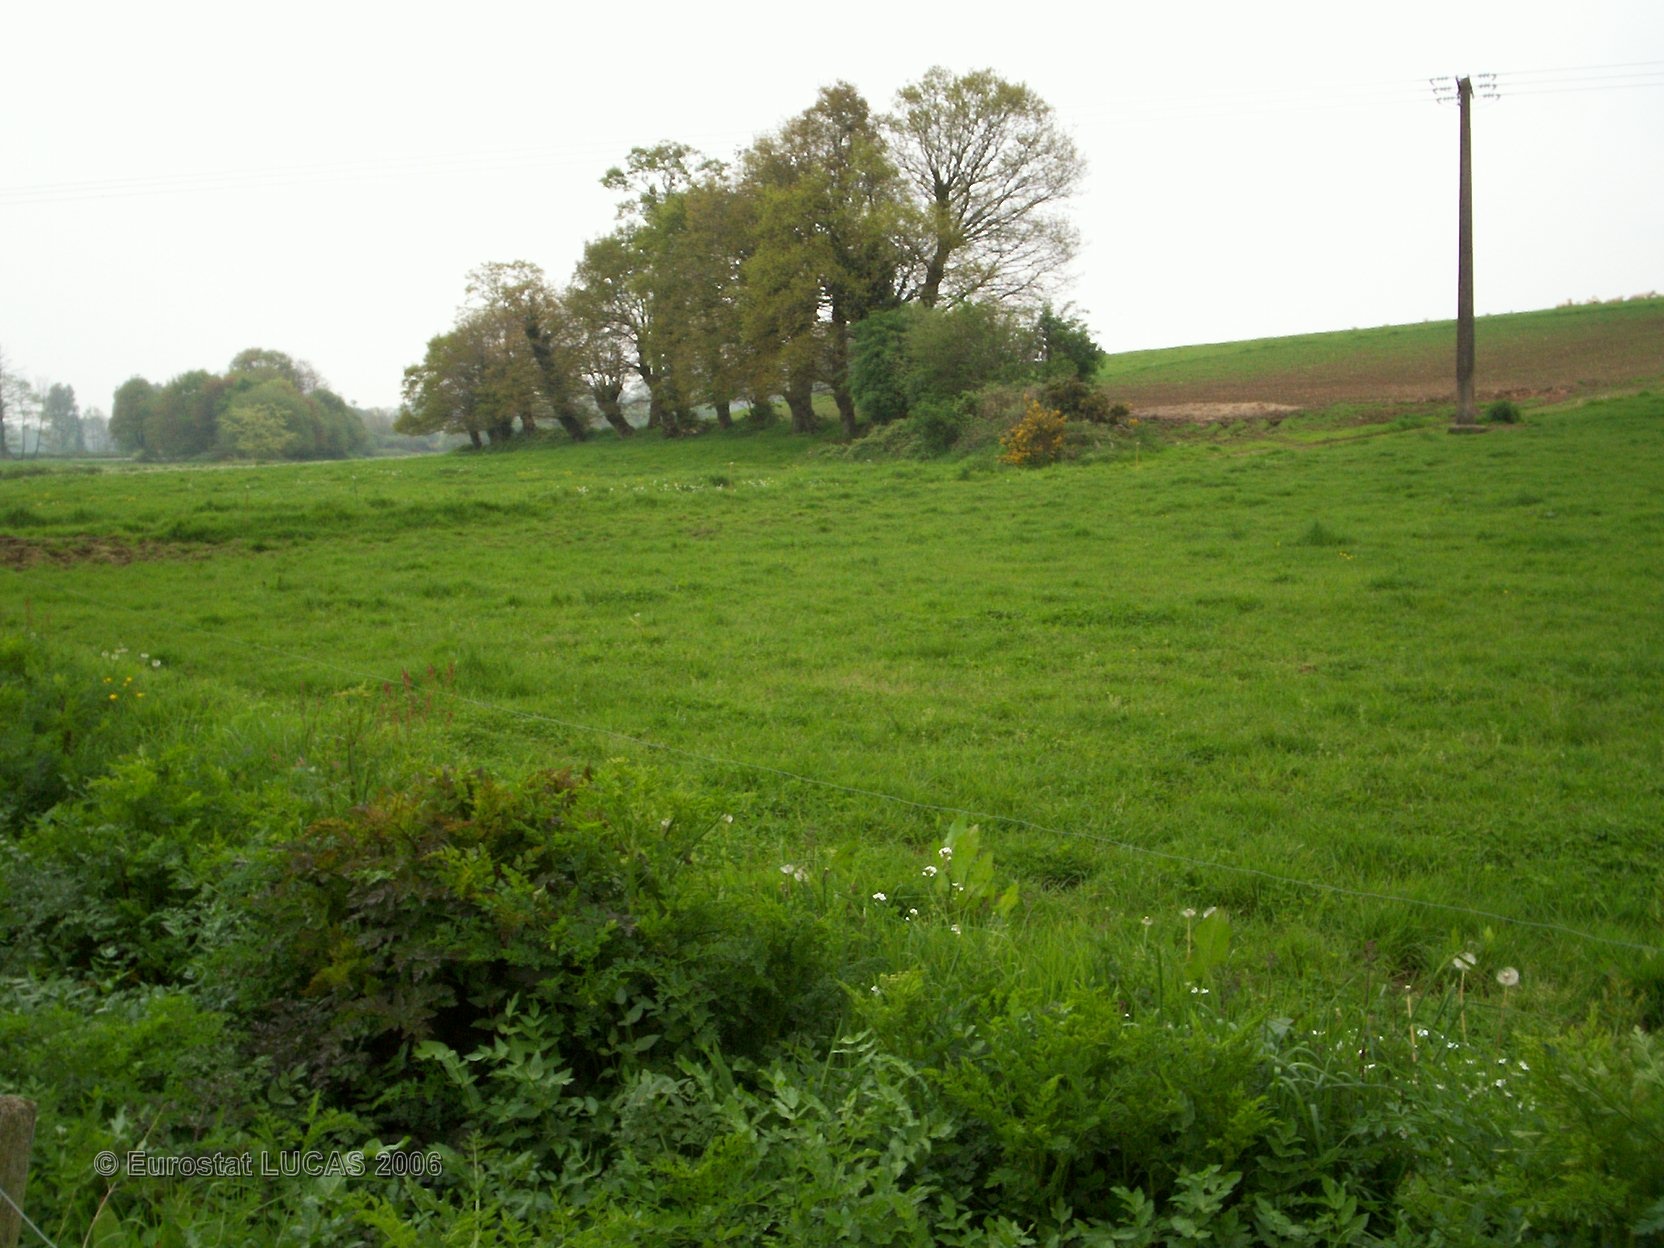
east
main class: Grassland
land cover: Grassland without tree/shrub cover
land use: Agriculture (excluding fallow land and kitchen gardens)
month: May
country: FR
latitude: 48.2067
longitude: -2.9181
